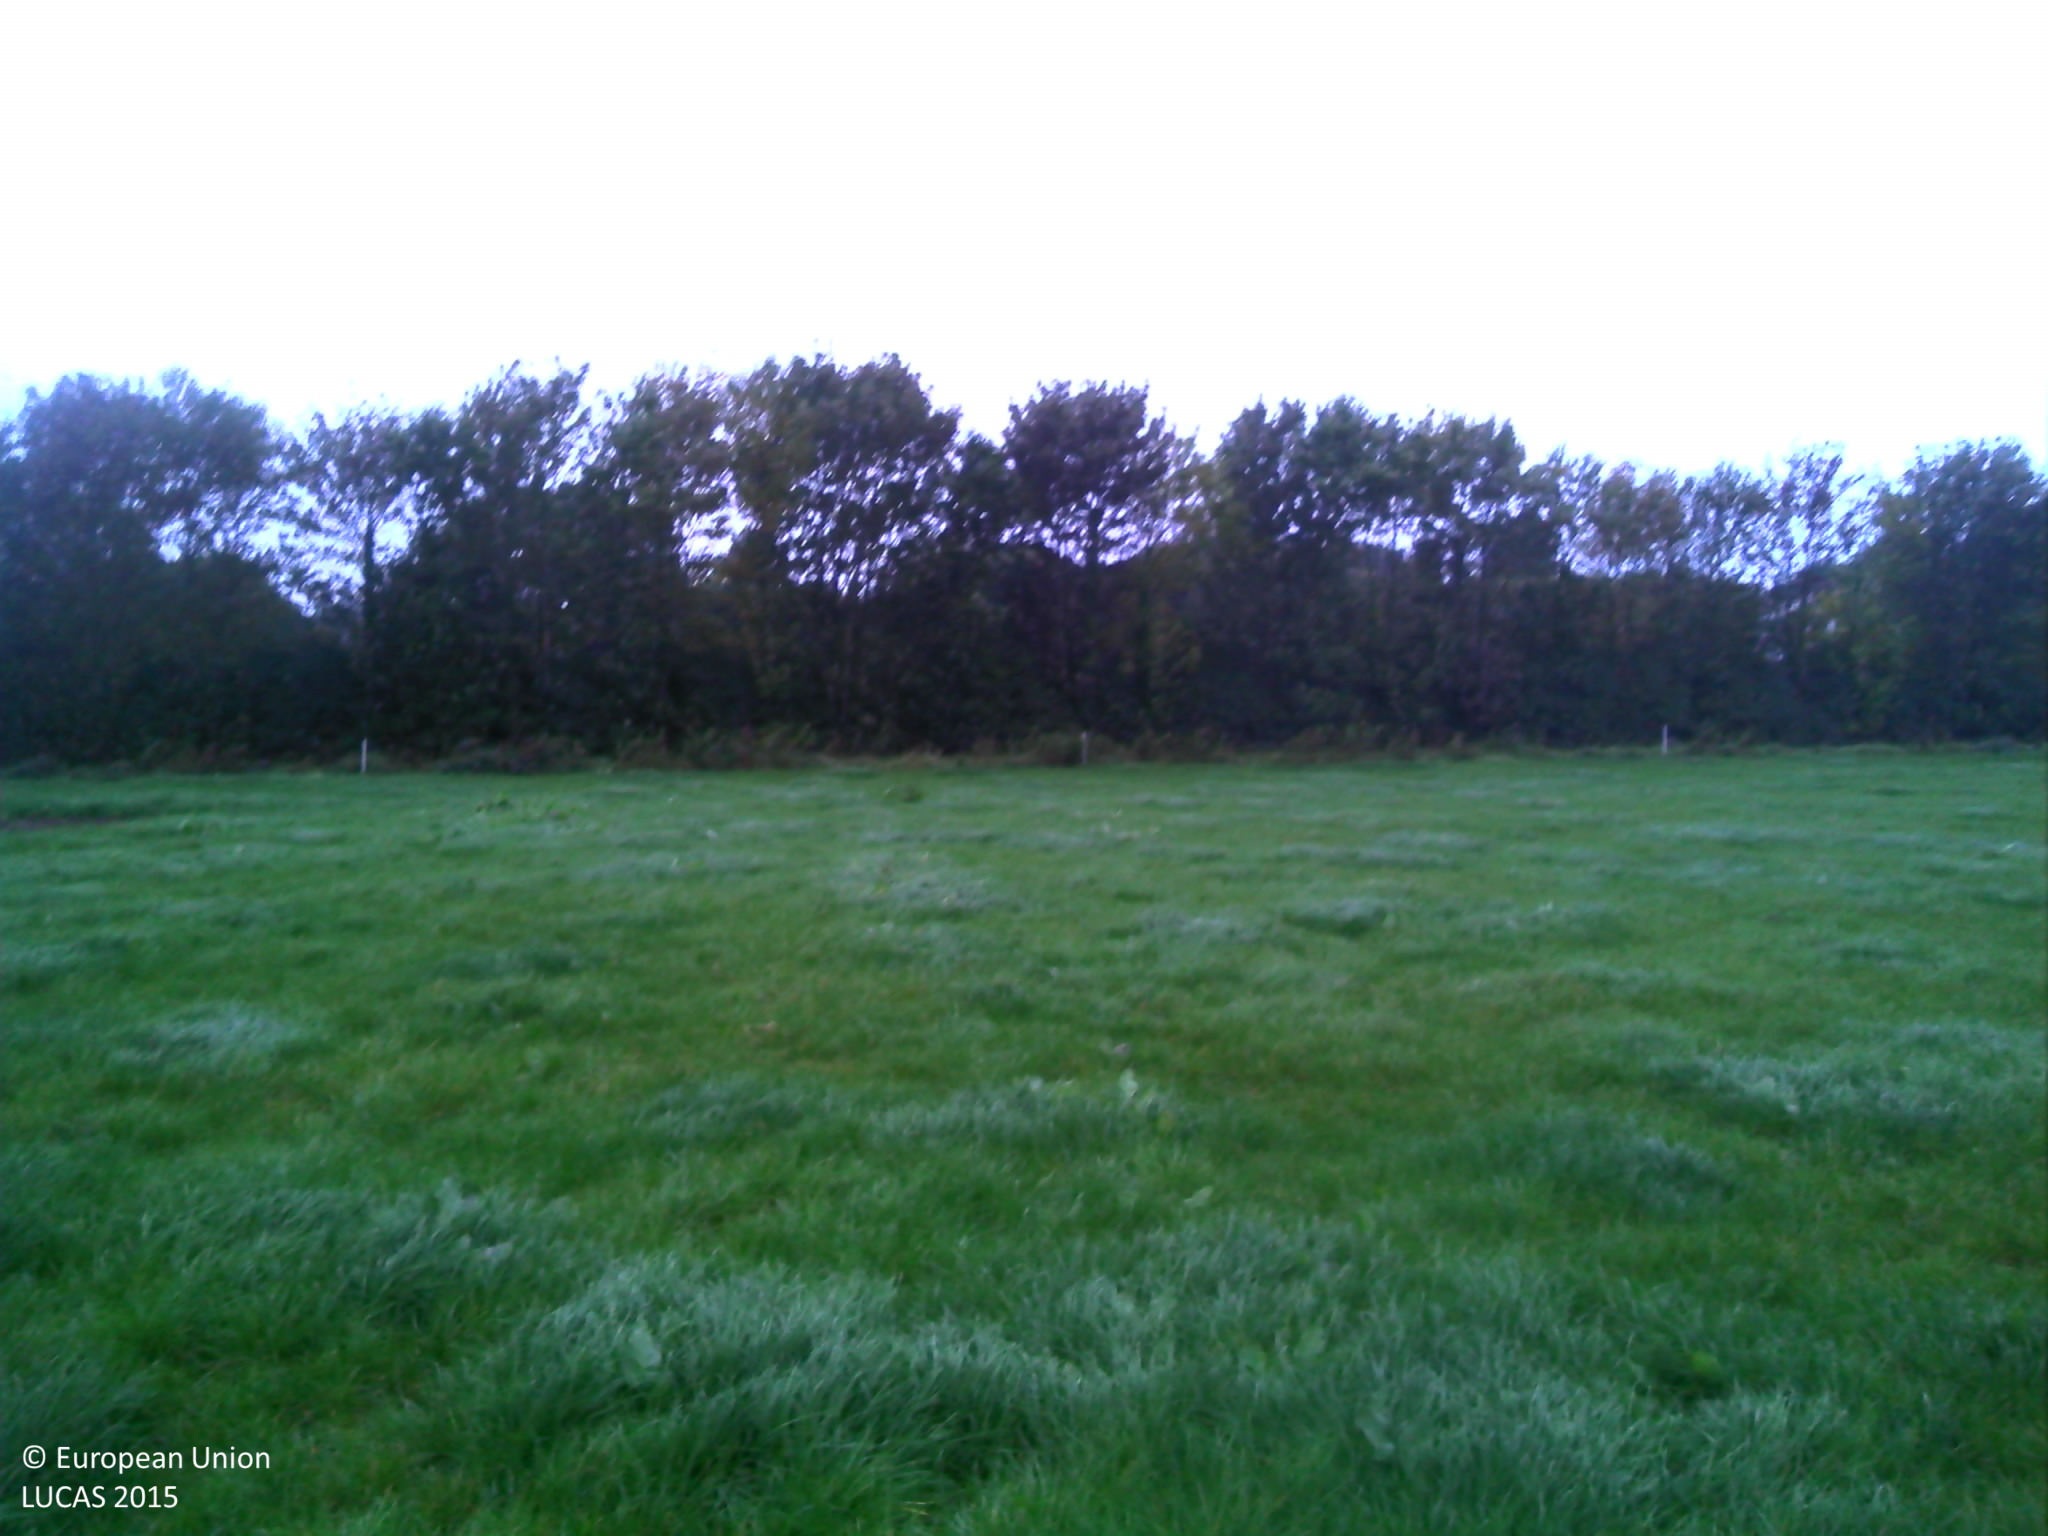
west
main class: Grassland
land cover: Grassland without tree/shrub cover
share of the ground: > 75 %
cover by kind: herbaceous plants 100 %
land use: Agriculture (excluding fallow land and kitchen gardens)
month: August
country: FR
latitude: 48.3290
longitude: -3.4167
